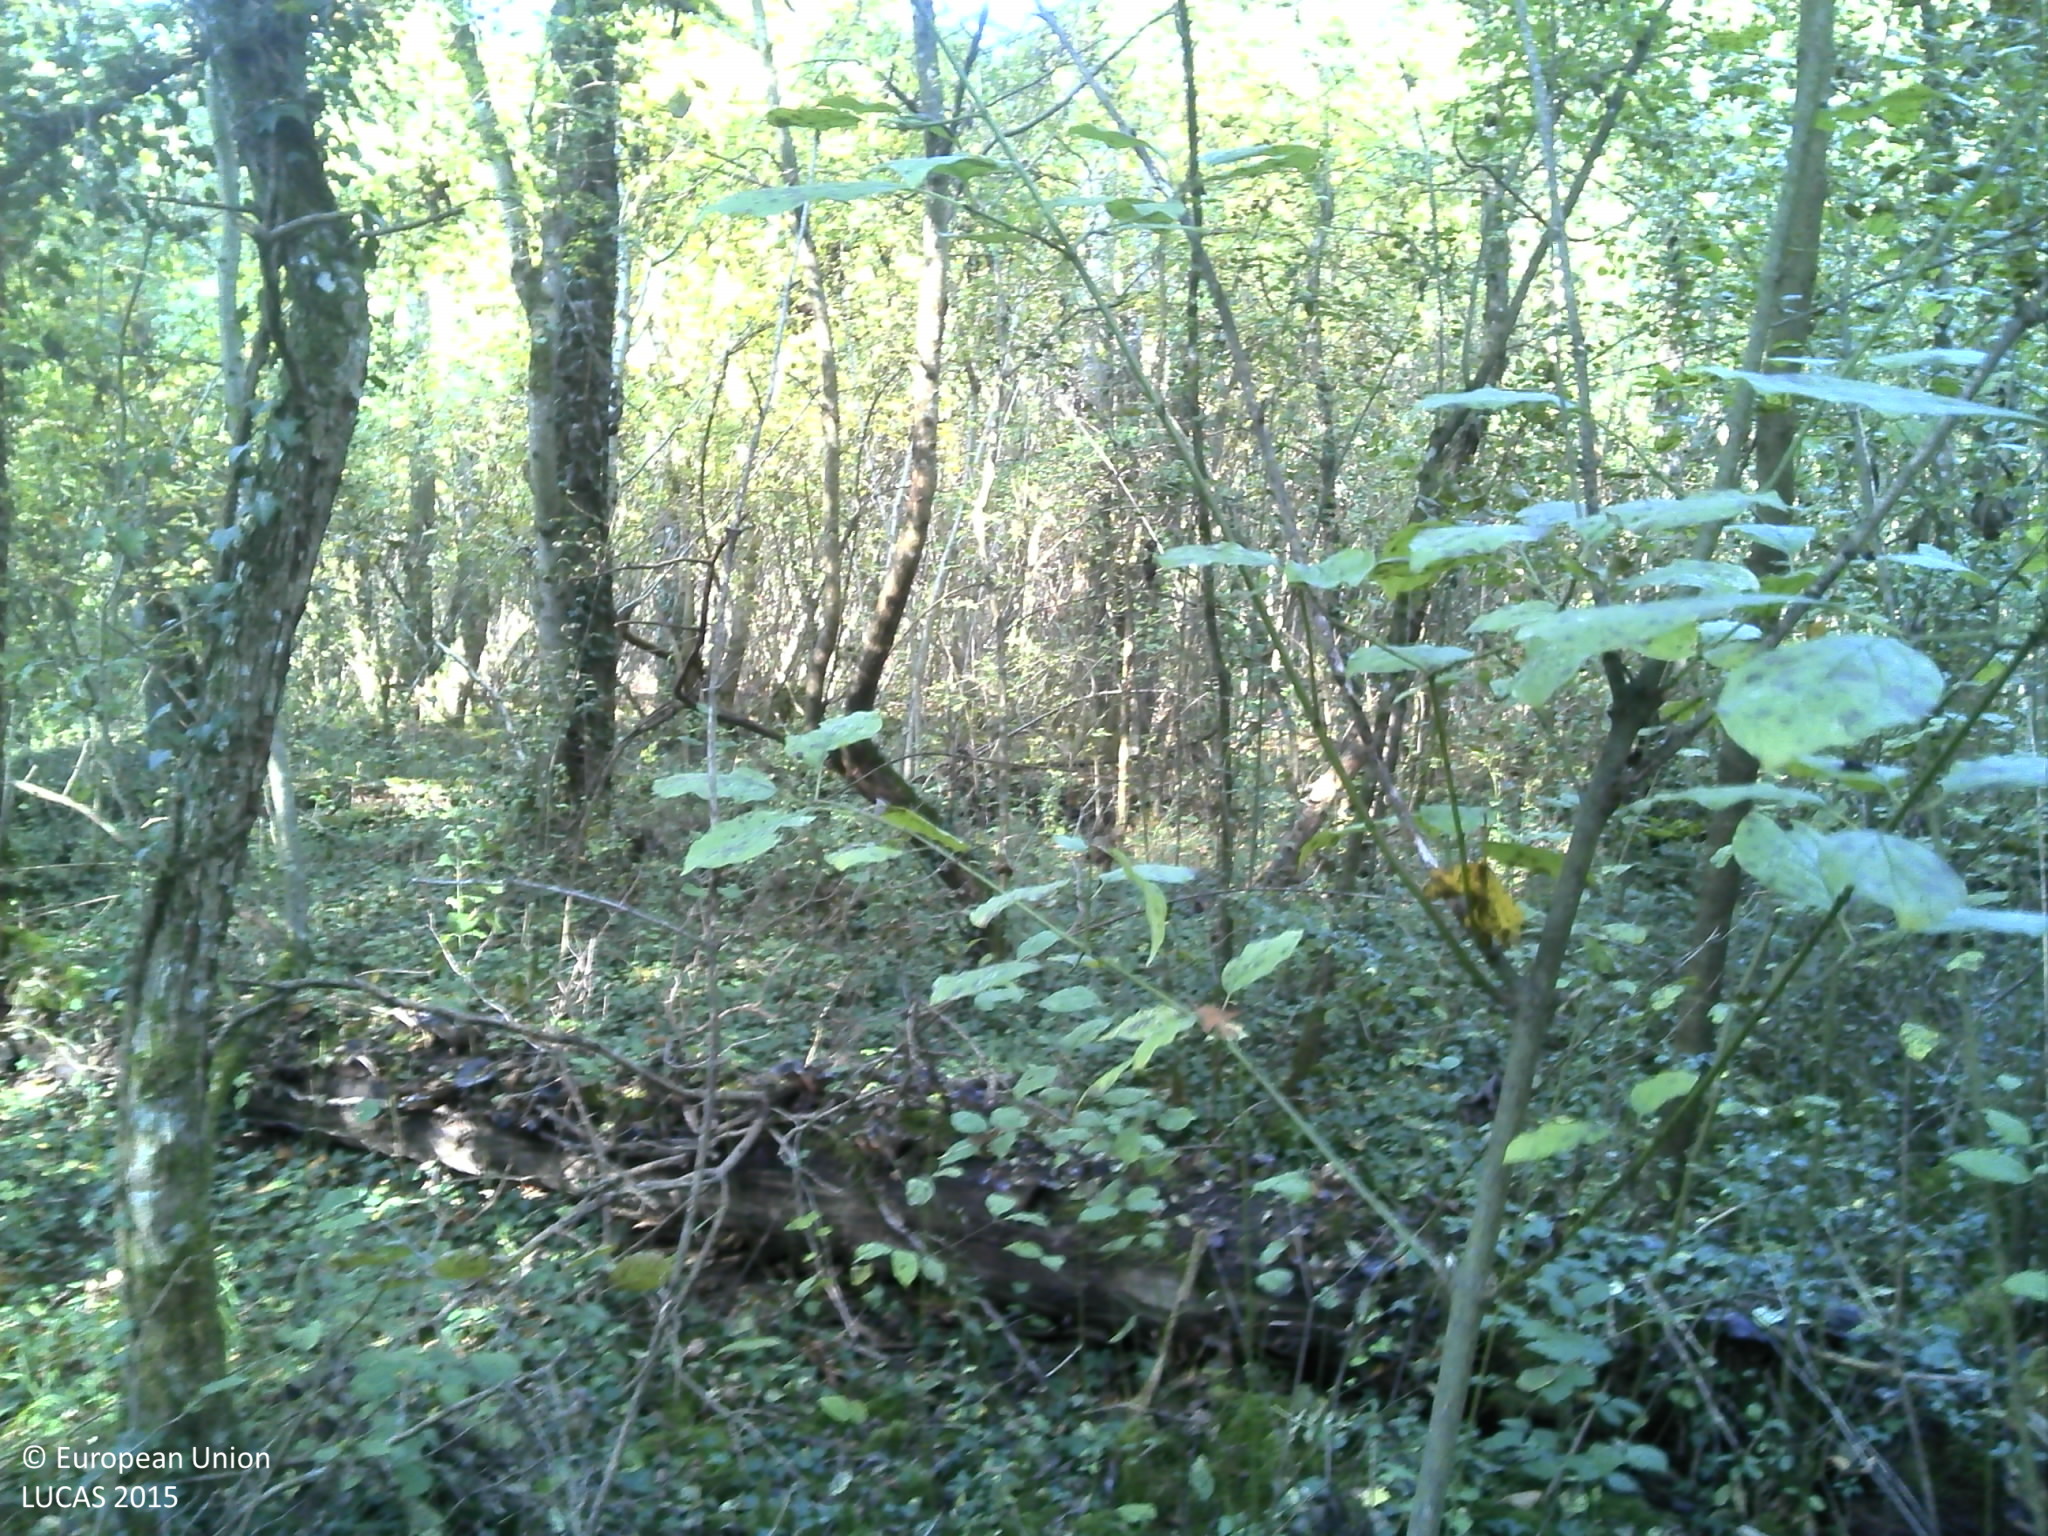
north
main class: Woodland
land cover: Broadleaved woodland
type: mesophytic deciduous forest
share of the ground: > 75 %
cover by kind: broadleaved forest trees 100 %
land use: Forestry
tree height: > 5 m
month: October
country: FR
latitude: 47.1854
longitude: 5.2899
